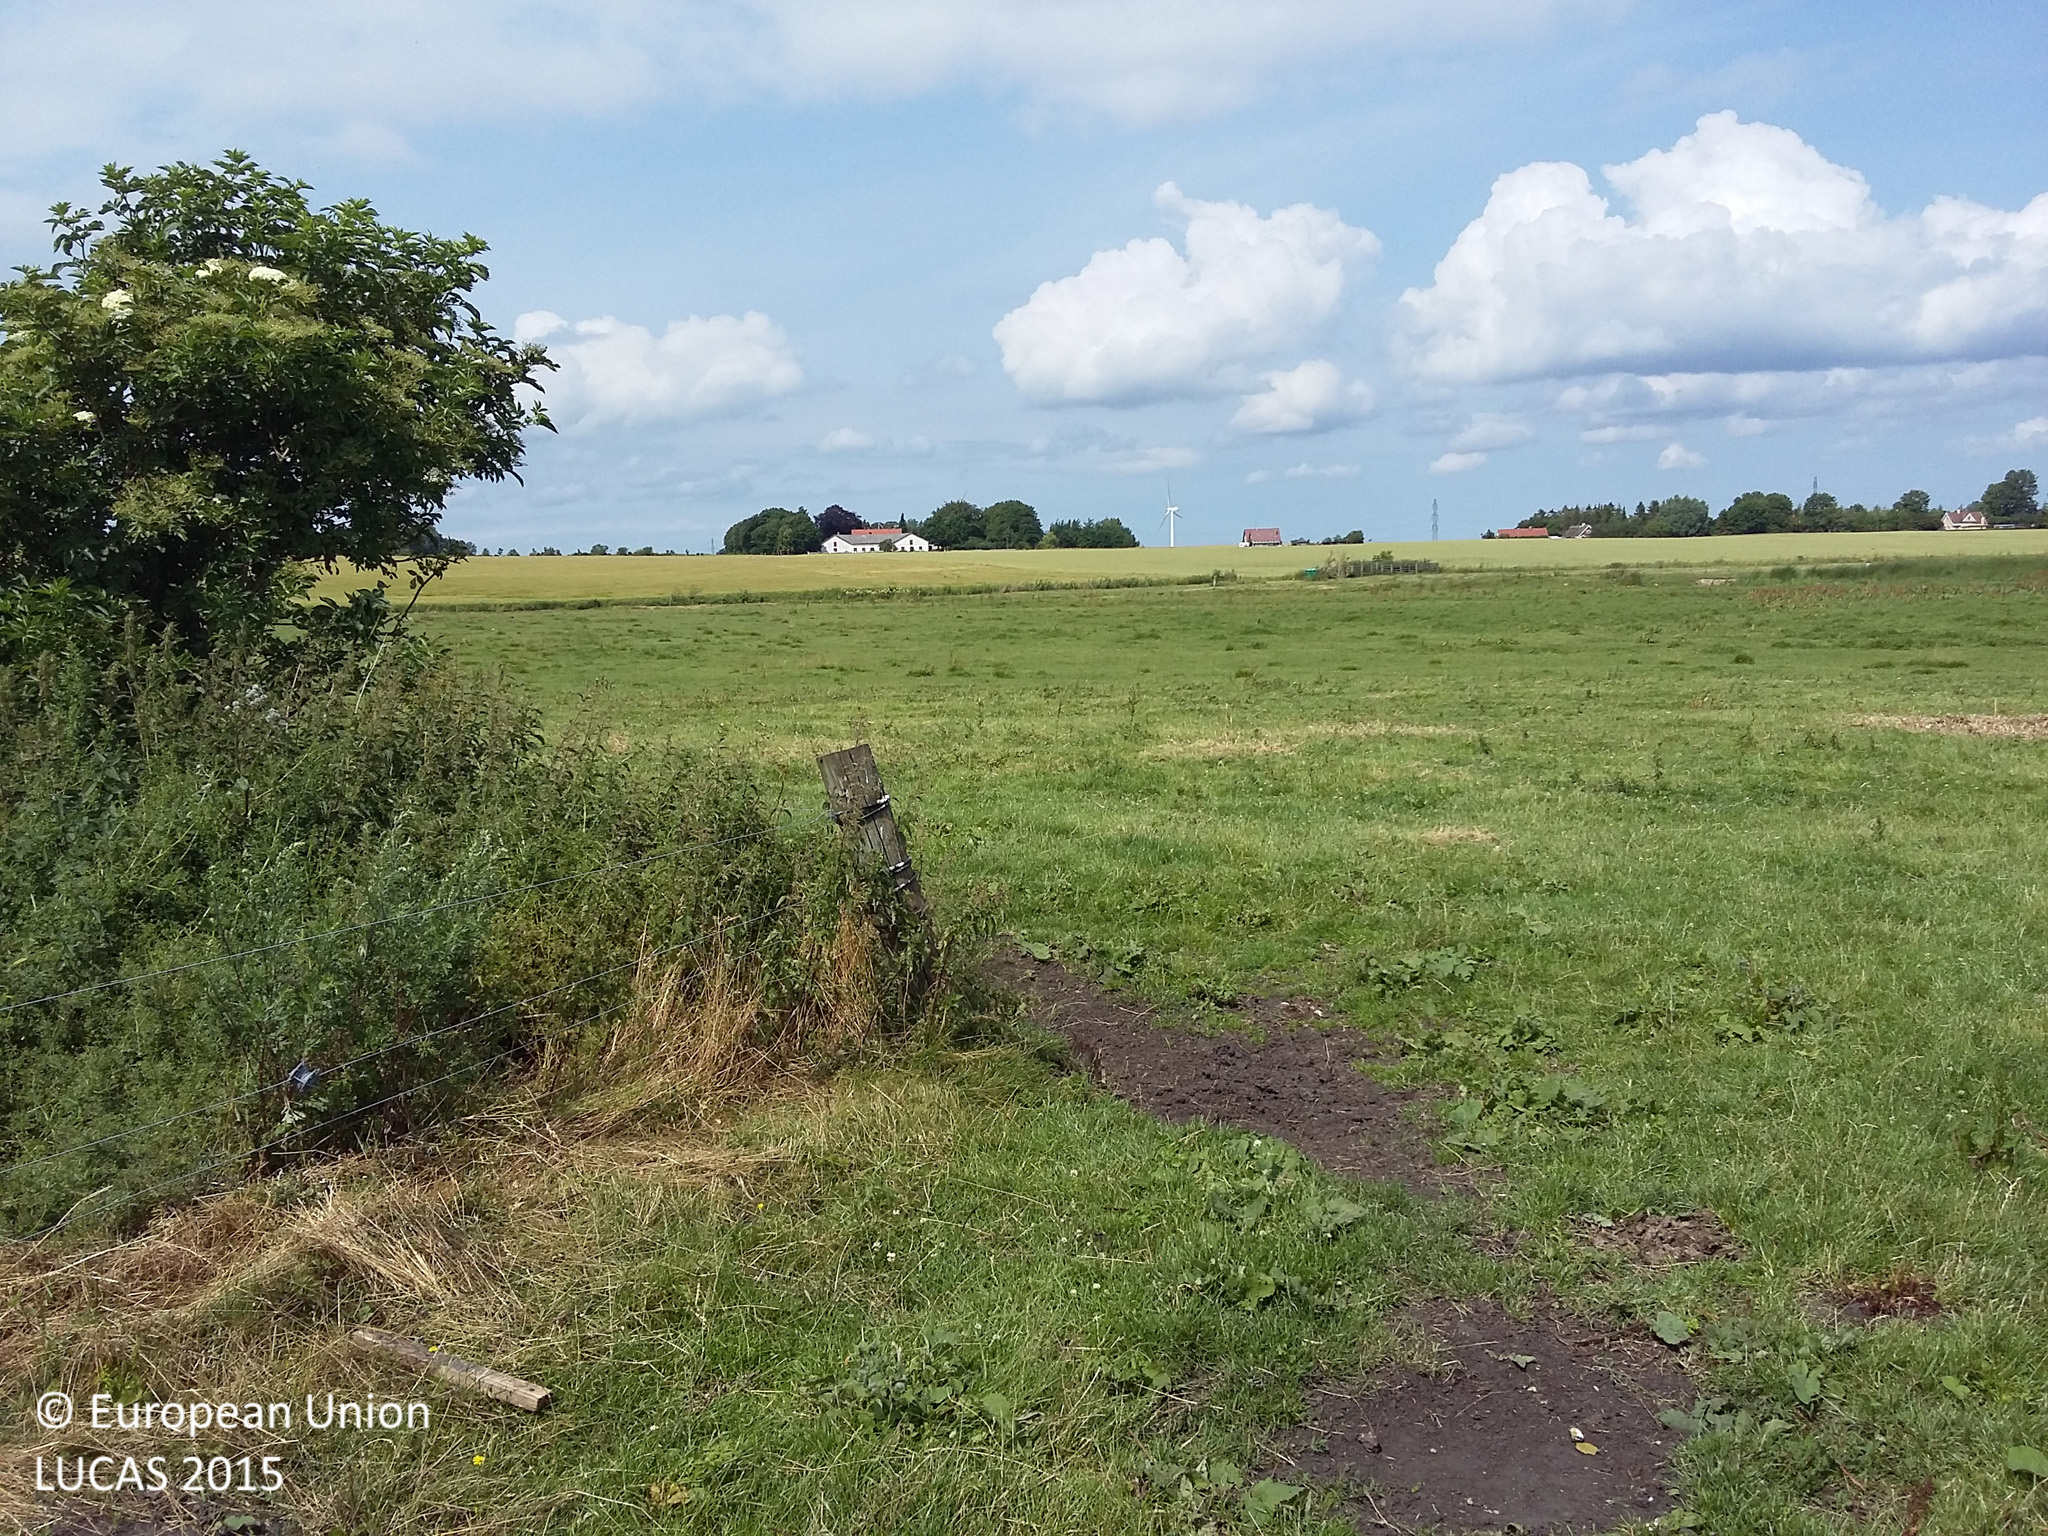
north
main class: Grassland
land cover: Grassland without tree/shrub cover
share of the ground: > 75 %
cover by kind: herbaceous plants 100 %
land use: Agriculture (excluding fallow land and kitchen gardens)
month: July
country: DK
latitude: 55.5345
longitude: 11.2506
